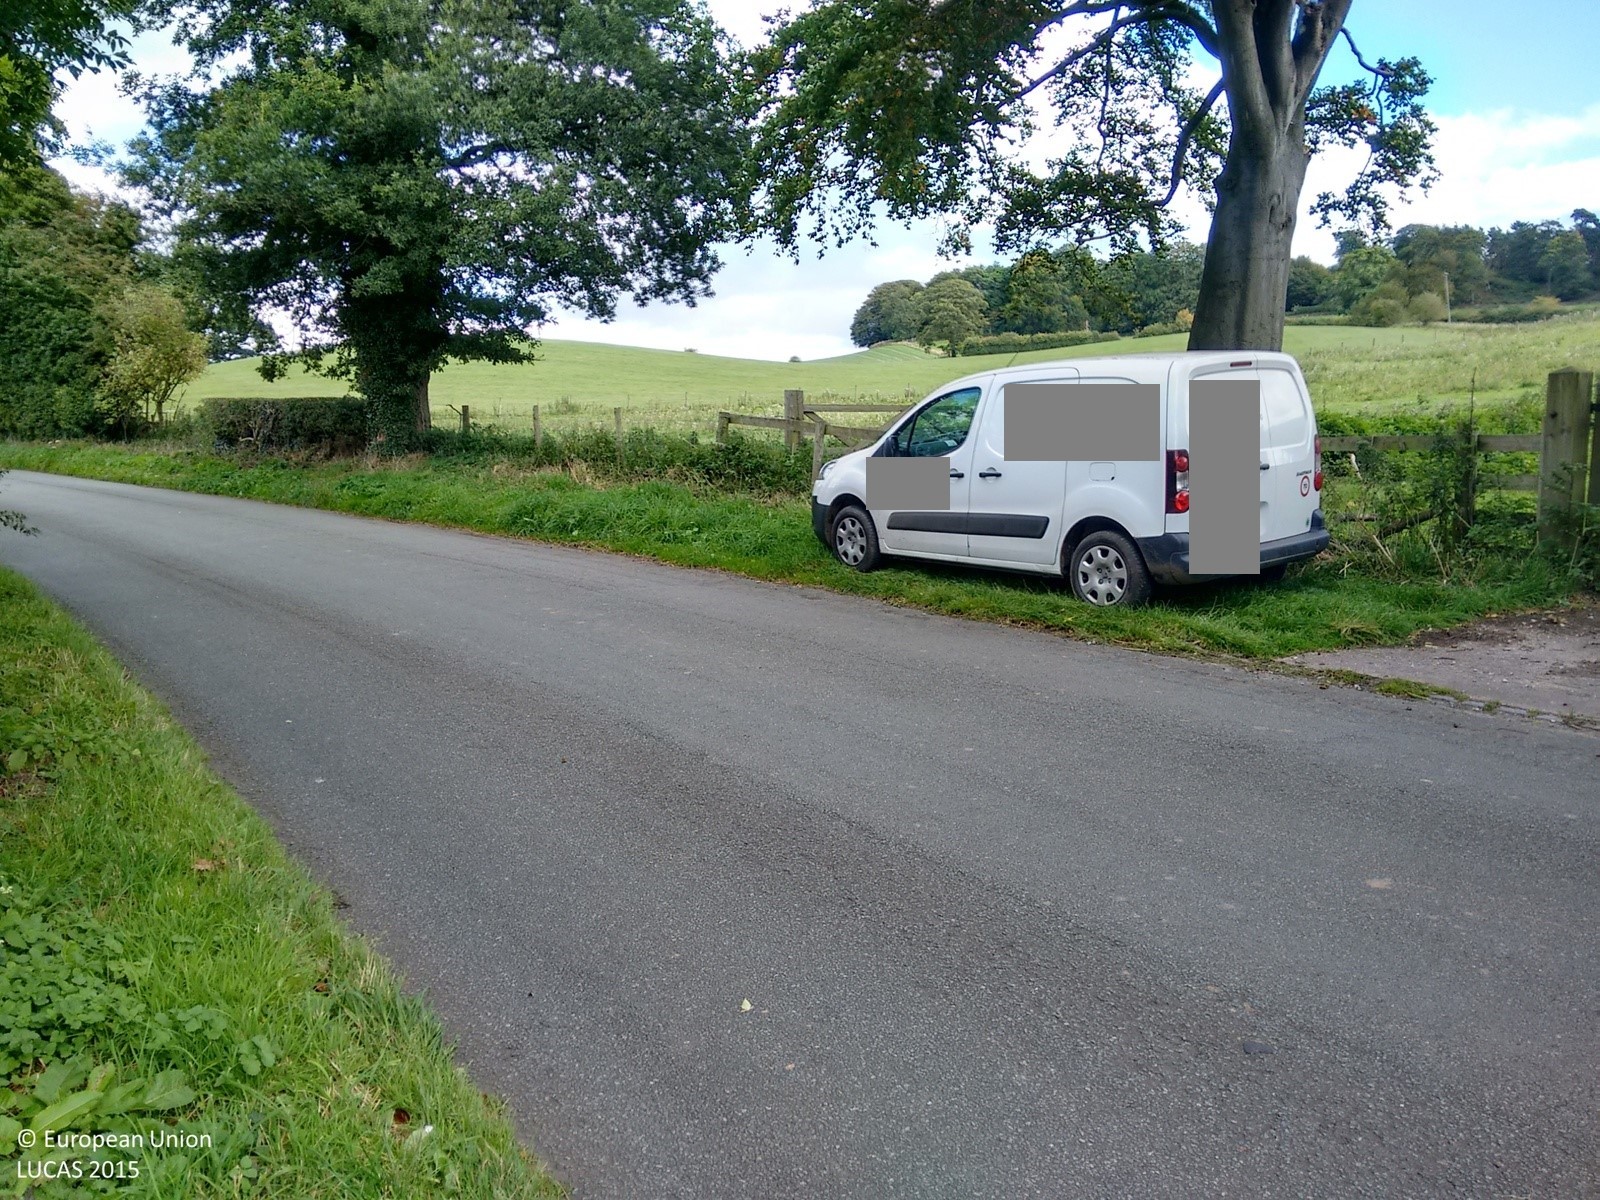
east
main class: Grassland
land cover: Grassland without tree/shrub cover
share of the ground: > 75 %
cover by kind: herbaceous plants 100 %
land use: Agriculture (excluding fallow land and kitchen gardens)
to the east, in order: Grassland without tree/shrub cover; Electric lines; Grassland without tree/shrub cover; Managed hedges; Electric lines; Grass margins; Paved roads, cycling and walking lanes; Grass margins; Managed hedges; Fences; Grassland without tree/shrub cover
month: September
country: GB
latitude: 52.8675
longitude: -2.0770
